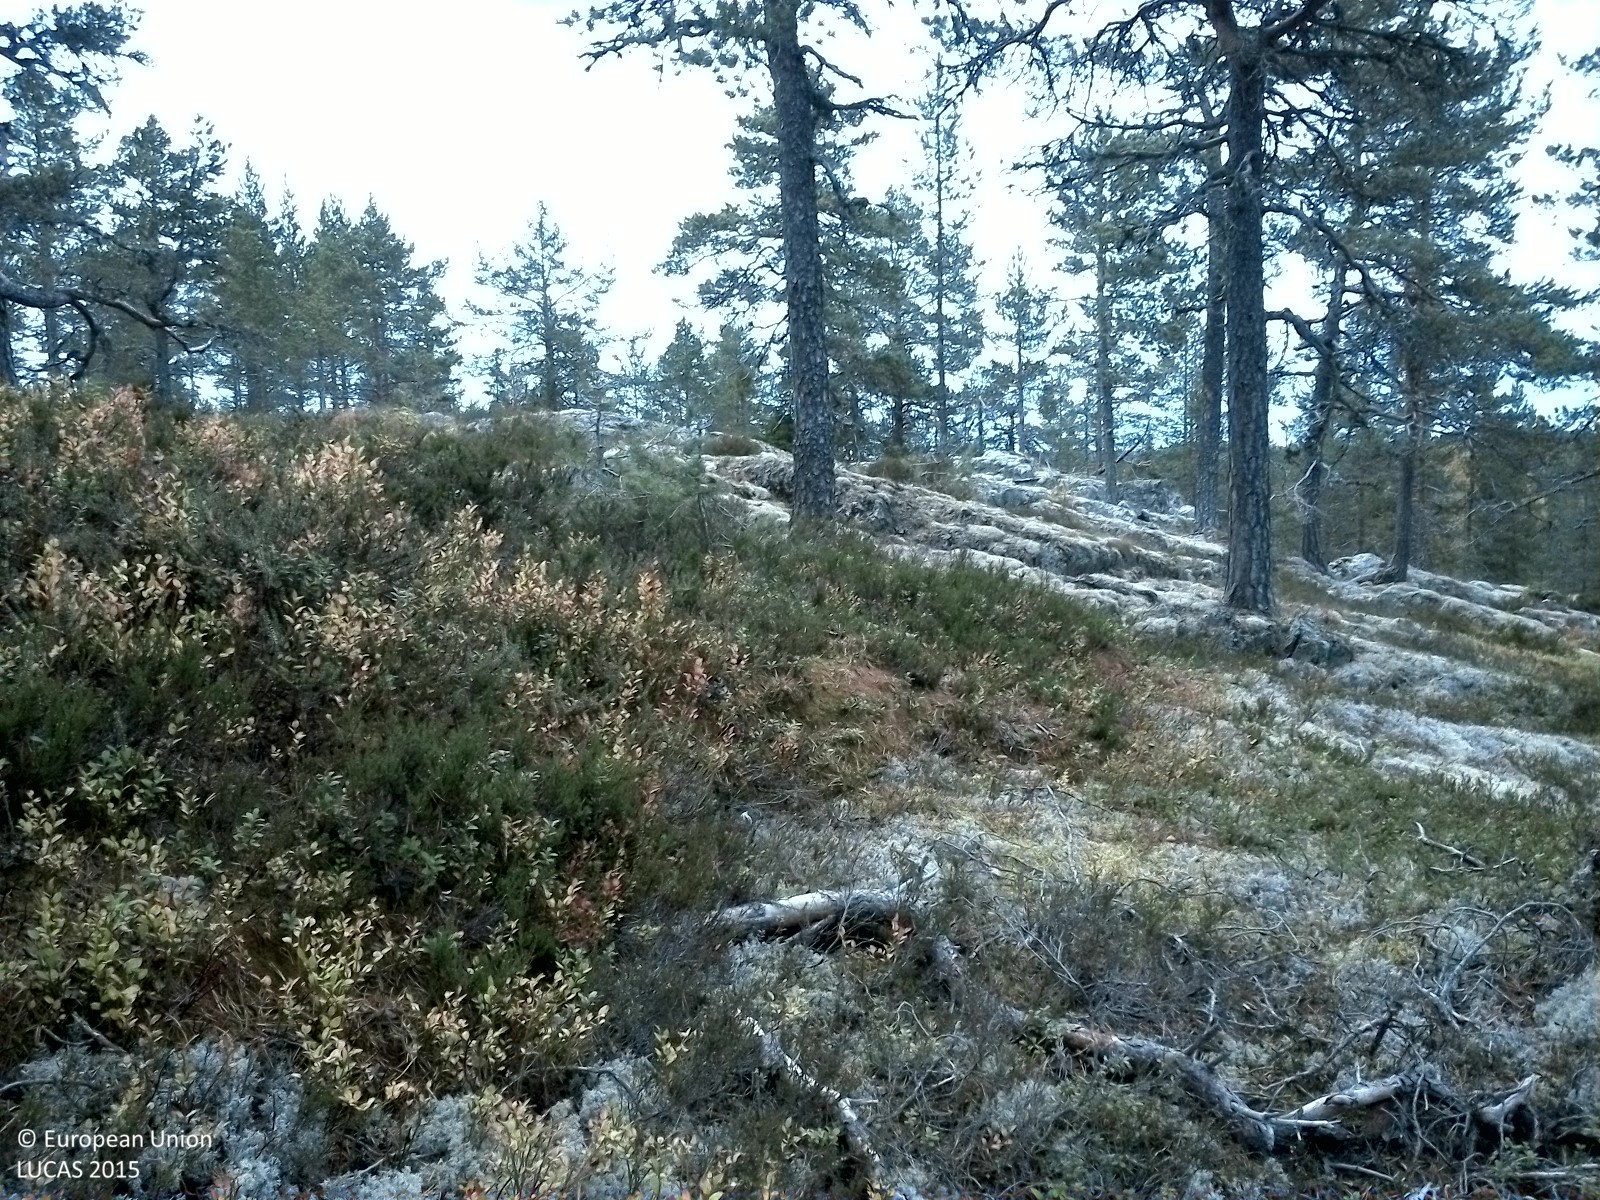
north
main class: Woodland
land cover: Pine dominated coniferous woodland
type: boreal forest
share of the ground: 25 - 50 %
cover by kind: lichens and mosses 40 %, shrubs 30 %, coniferous forest trees 25 %
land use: Forestry
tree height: > 5 m
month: October
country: SE
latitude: 62.5621
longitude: 17.6640
